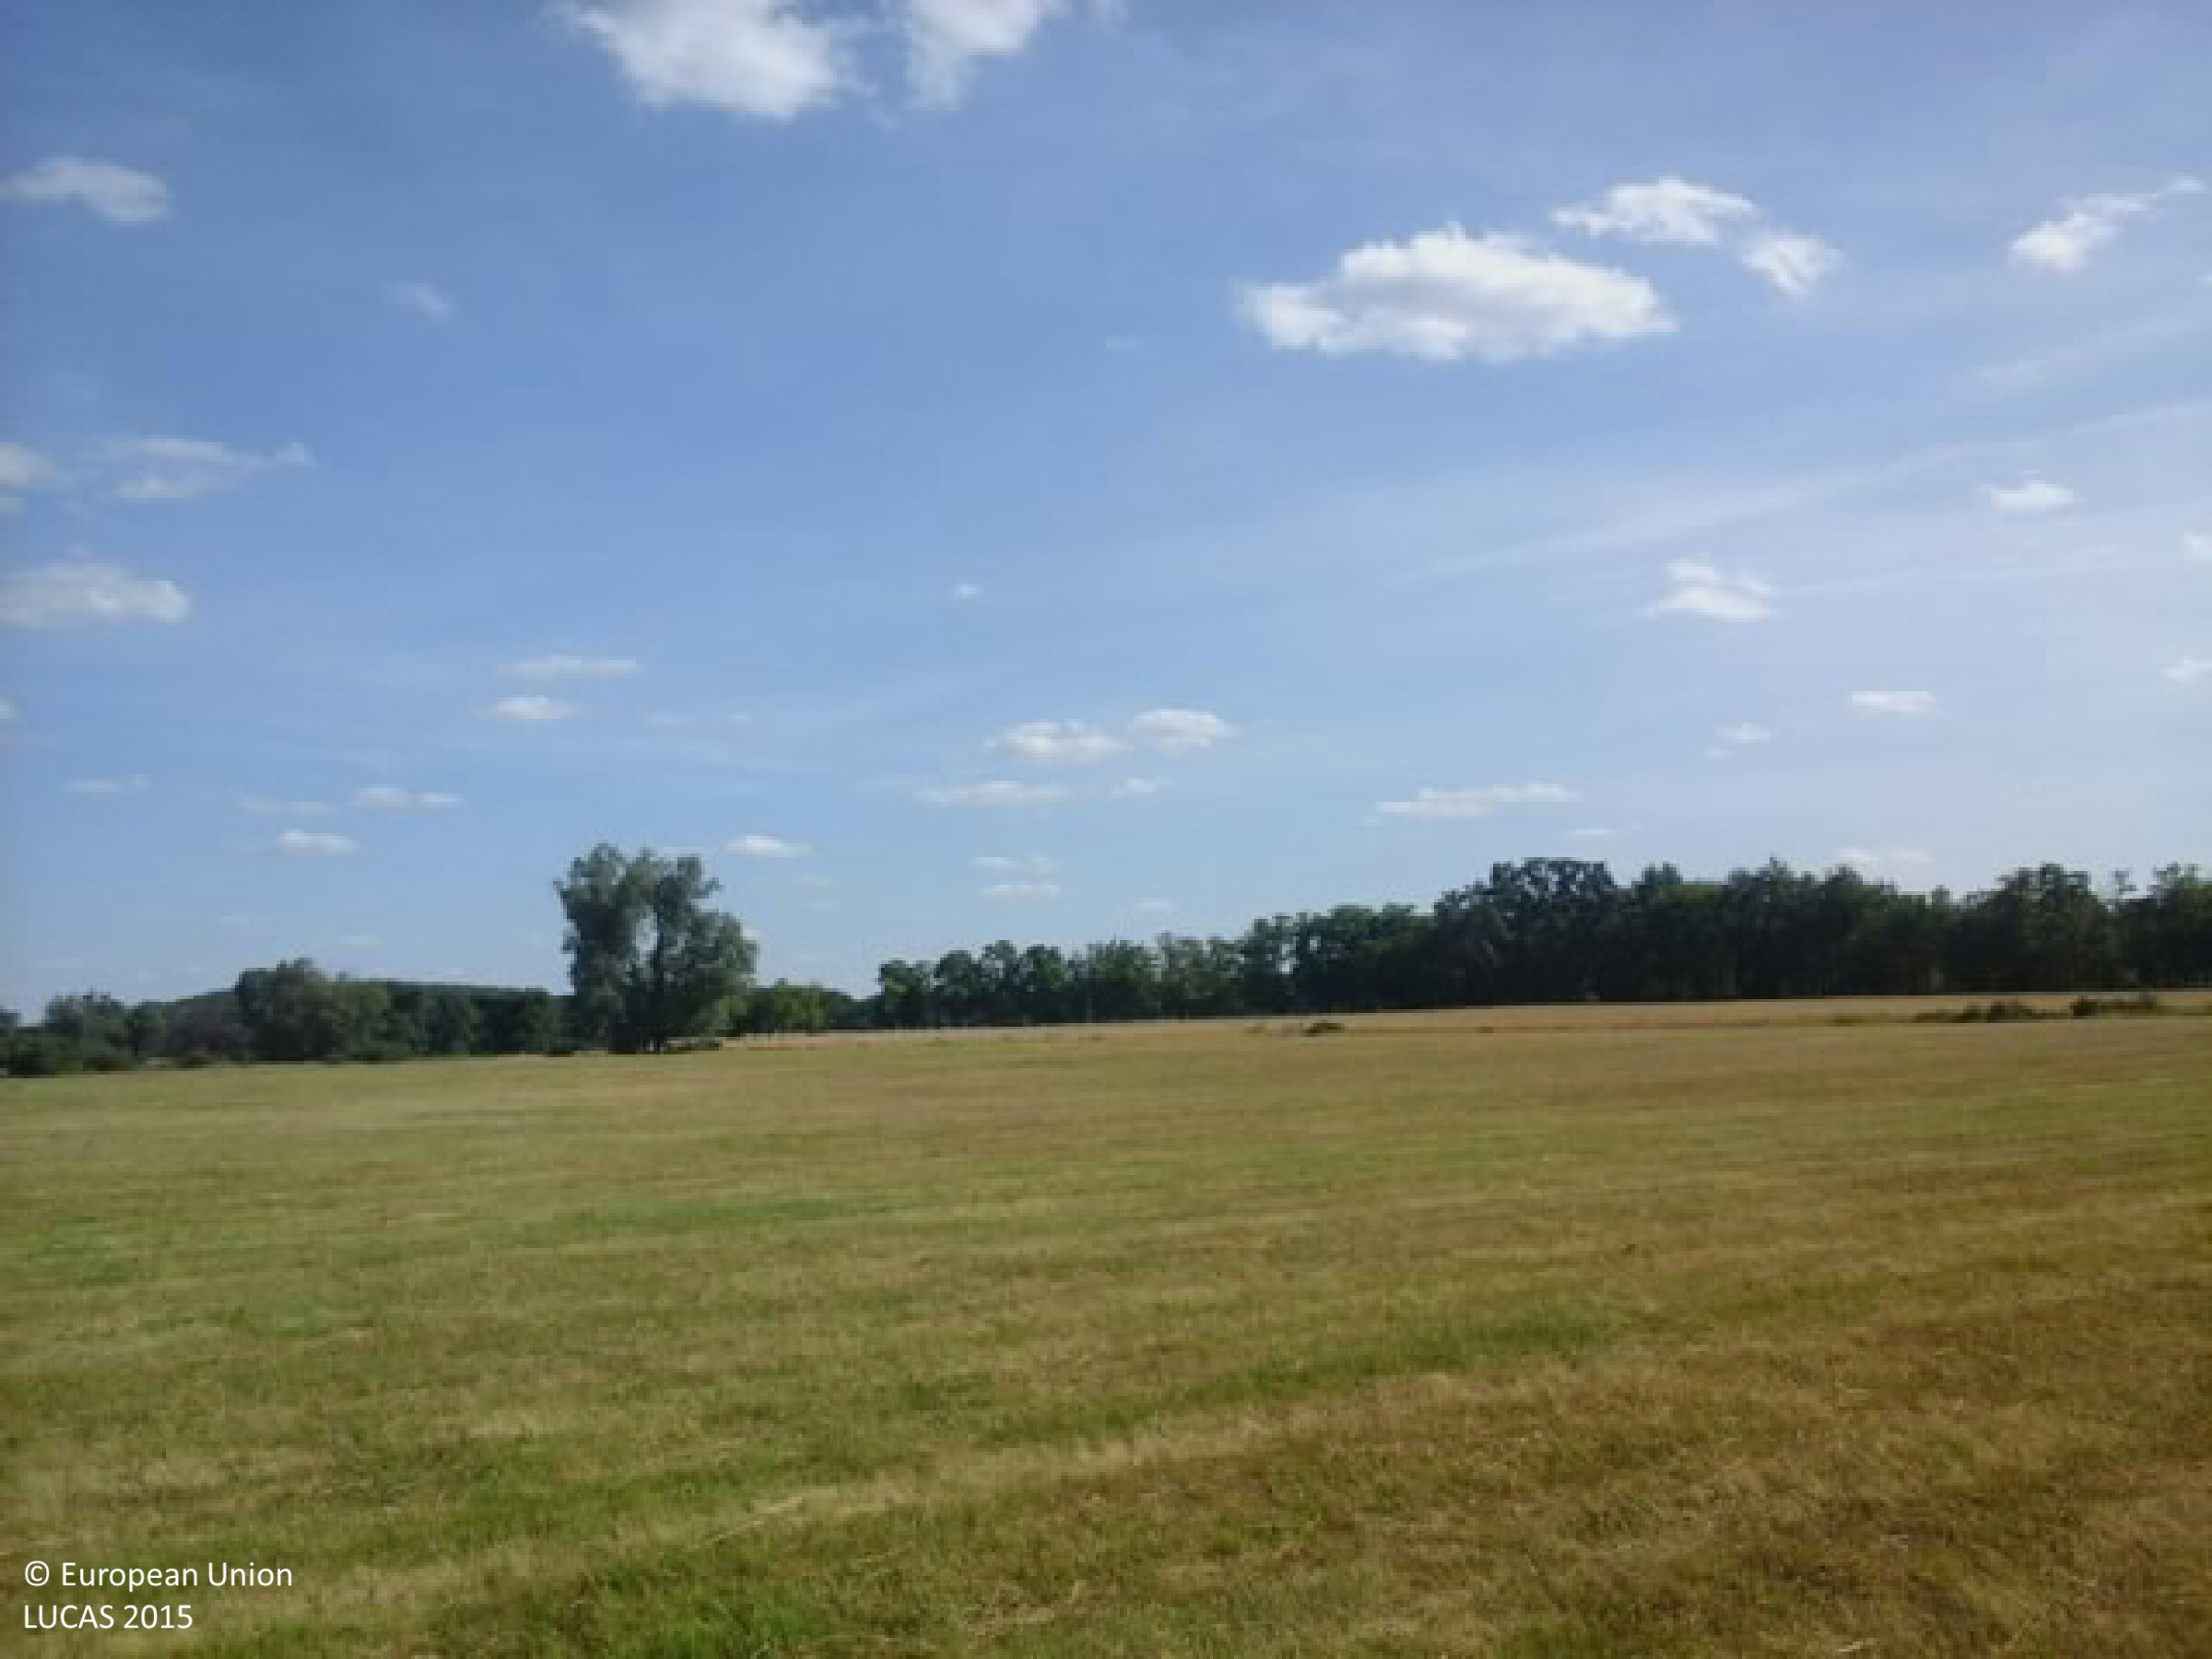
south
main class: Grassland
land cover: Grassland without tree/shrub cover
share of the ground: > 75 %
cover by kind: herbaceous plants 100 %
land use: Agriculture (excluding fallow land and kitchen gardens)
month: June
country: HU
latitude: 46.2811
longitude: 19.1898
